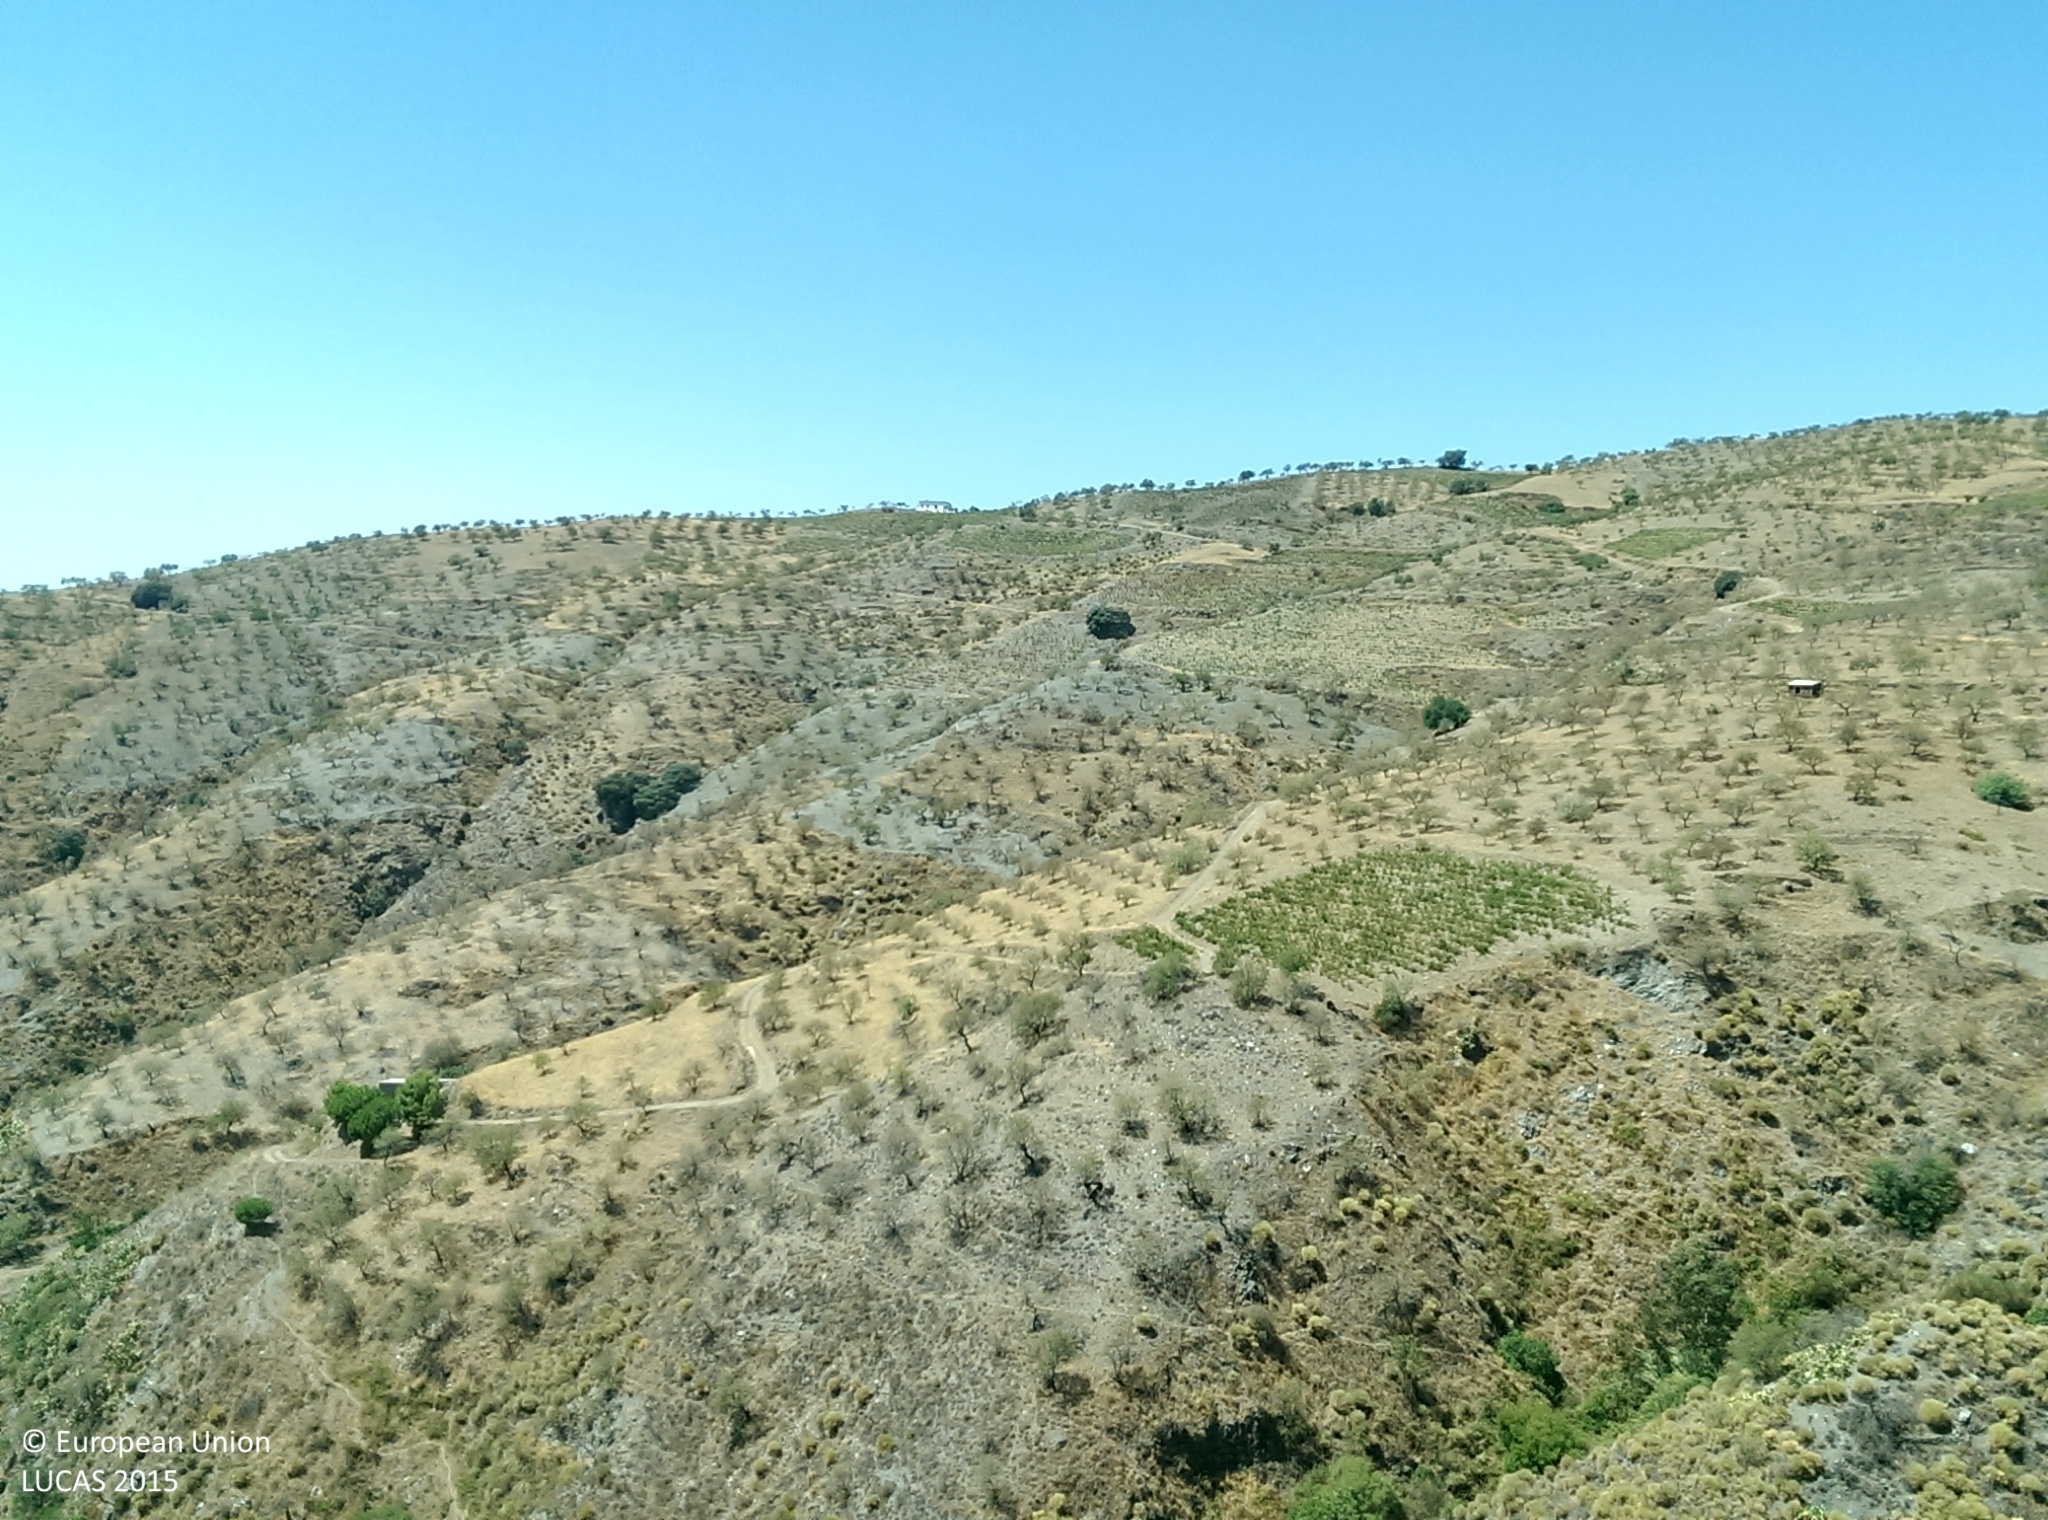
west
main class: Shrubland
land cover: Shrubland with sparse tree cover
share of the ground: > 75 %
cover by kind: shrubs 75 %, herbaceous plants 20 %, broadleaved forest trees 5 %
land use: Abandoned areas
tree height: < 5 m
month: August
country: ES
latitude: 36.8233
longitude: -3.1980
